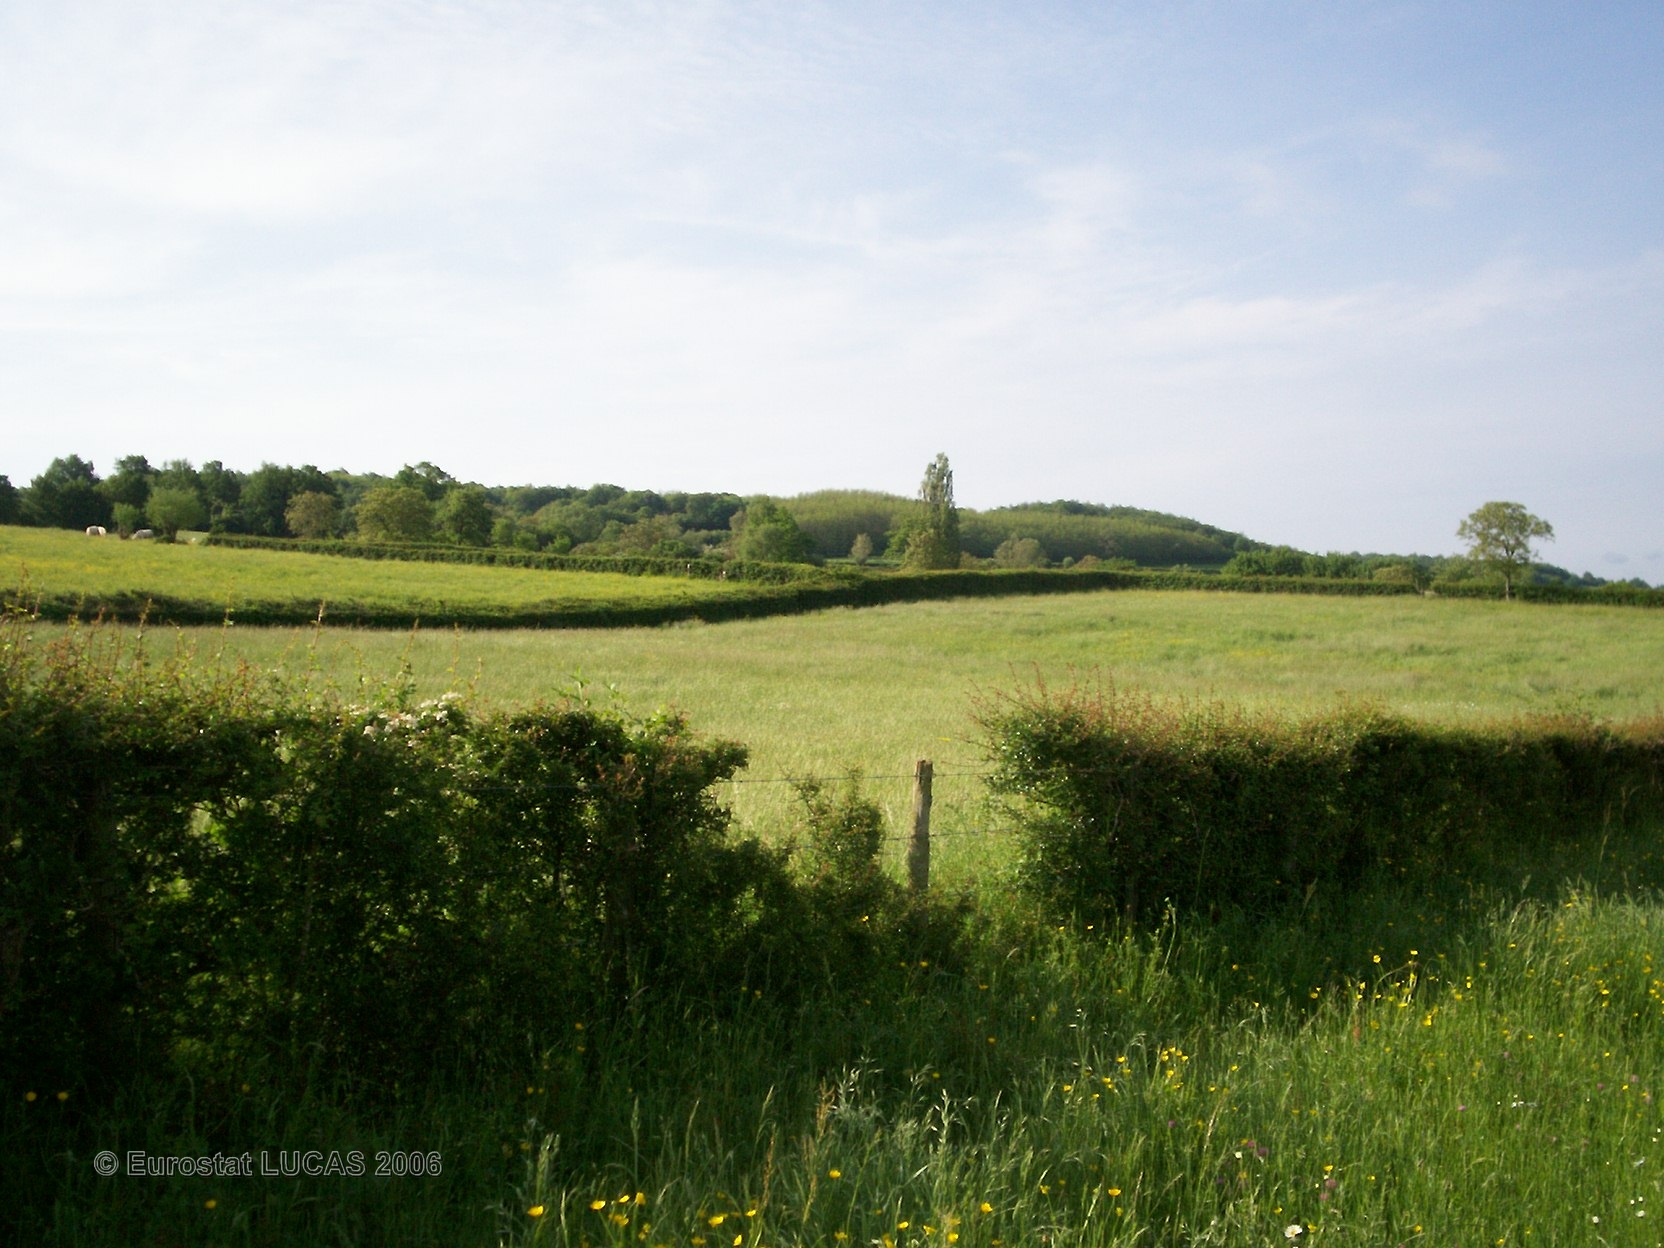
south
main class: Grassland
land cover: Grassland without tree/shrub cover
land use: Agriculture (excluding fallow land and kitchen gardens)
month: May
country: FR
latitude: 46.7406
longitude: 4.6480
